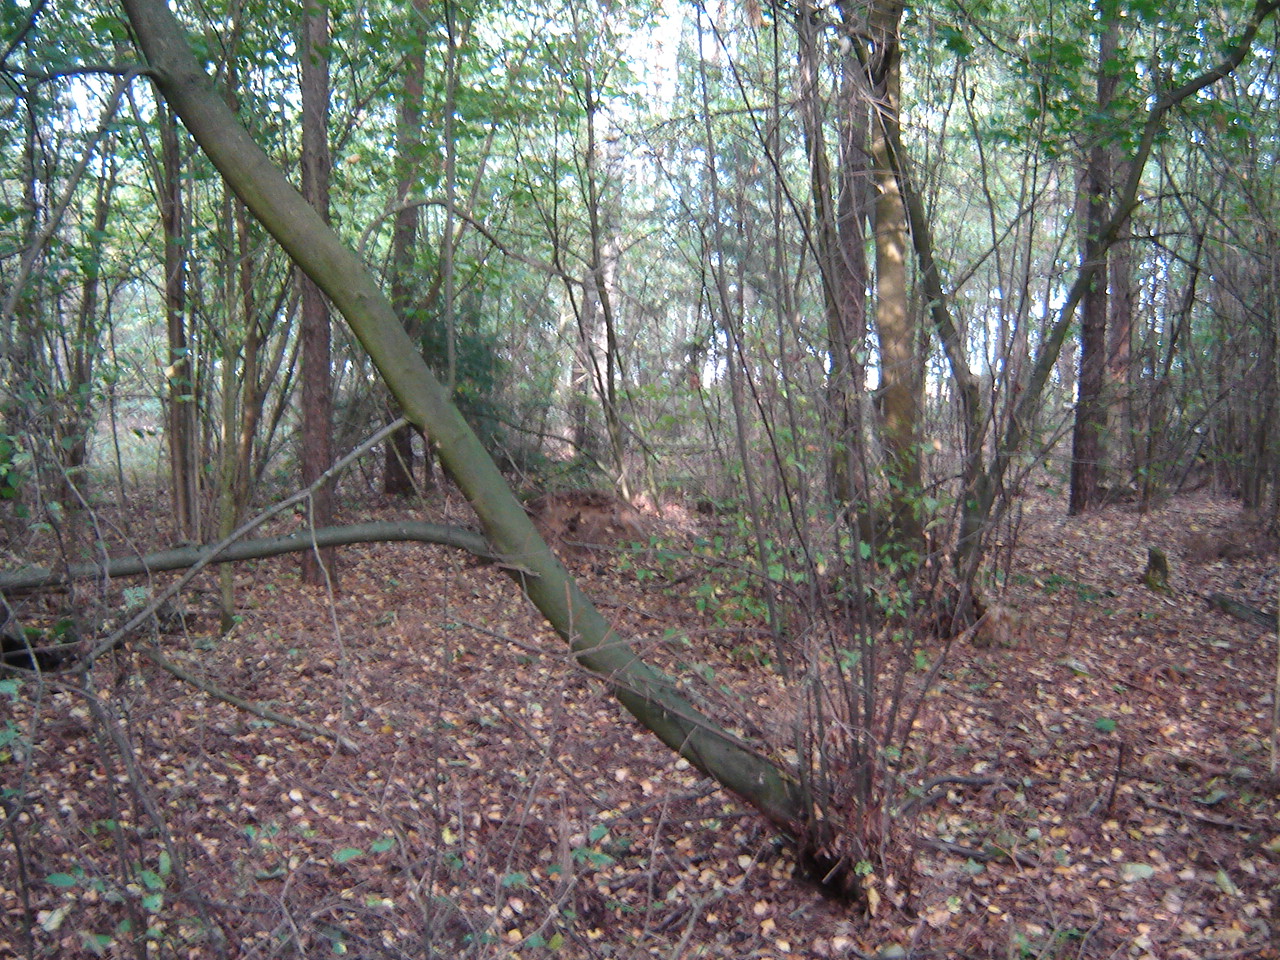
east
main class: Woodland
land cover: Pine dominated mixed woodland
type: hemiboreal forest and nemoral coniferous forest and mixed broadleaved-coniferous forest
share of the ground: > 75 %
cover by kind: broadleaved forest trees 50 %, coniferous forest trees 40 %, herbaceous plants 5 %, unconsolidated bare surface 5 %
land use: Forestry
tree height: > 5 m
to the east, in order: Pine dominated mixed woodland; Ditches and canals; Groves; Tracks; Grass margins; Oats; Common wheat
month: September
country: LT
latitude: 54.1958
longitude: 25.0300
